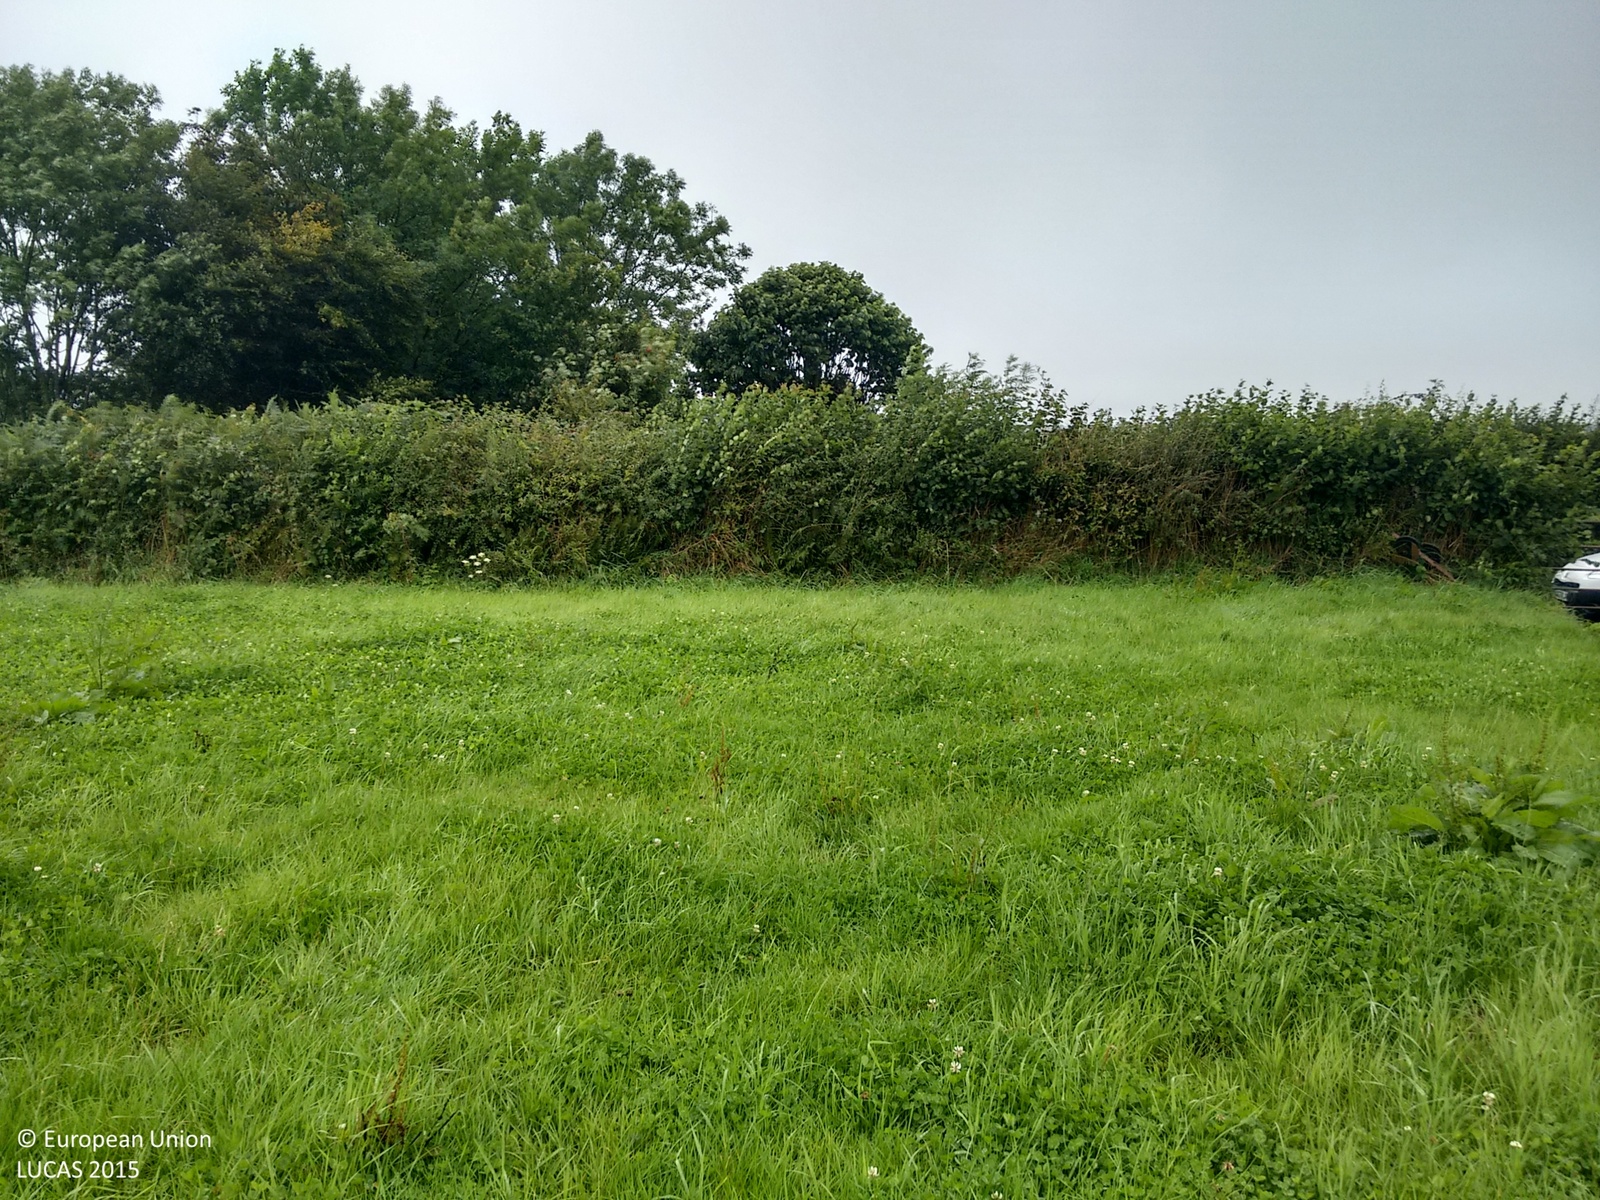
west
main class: Grassland
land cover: Grassland without tree/shrub cover
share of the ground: > 75 %
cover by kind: herbaceous plants 100 %
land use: Agriculture (excluding fallow land and kitchen gardens)
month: August
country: GB
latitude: 50.8858
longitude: -3.6914
